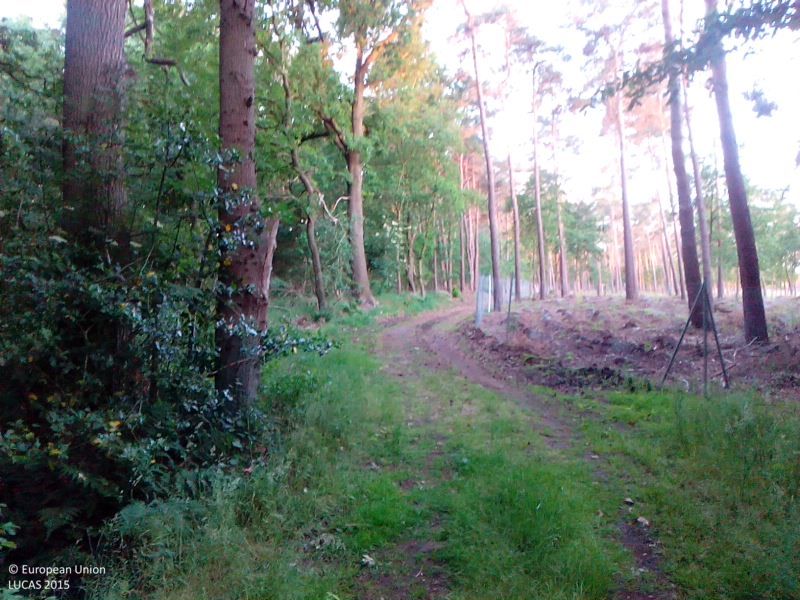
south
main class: Grassland
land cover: Spontaneously vegetated surfaces
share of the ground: > 75 %
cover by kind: herbaceous plants 95 %, shrubs 5 %
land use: Forestry
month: June
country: DE
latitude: 52.5639
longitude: 7.3597
